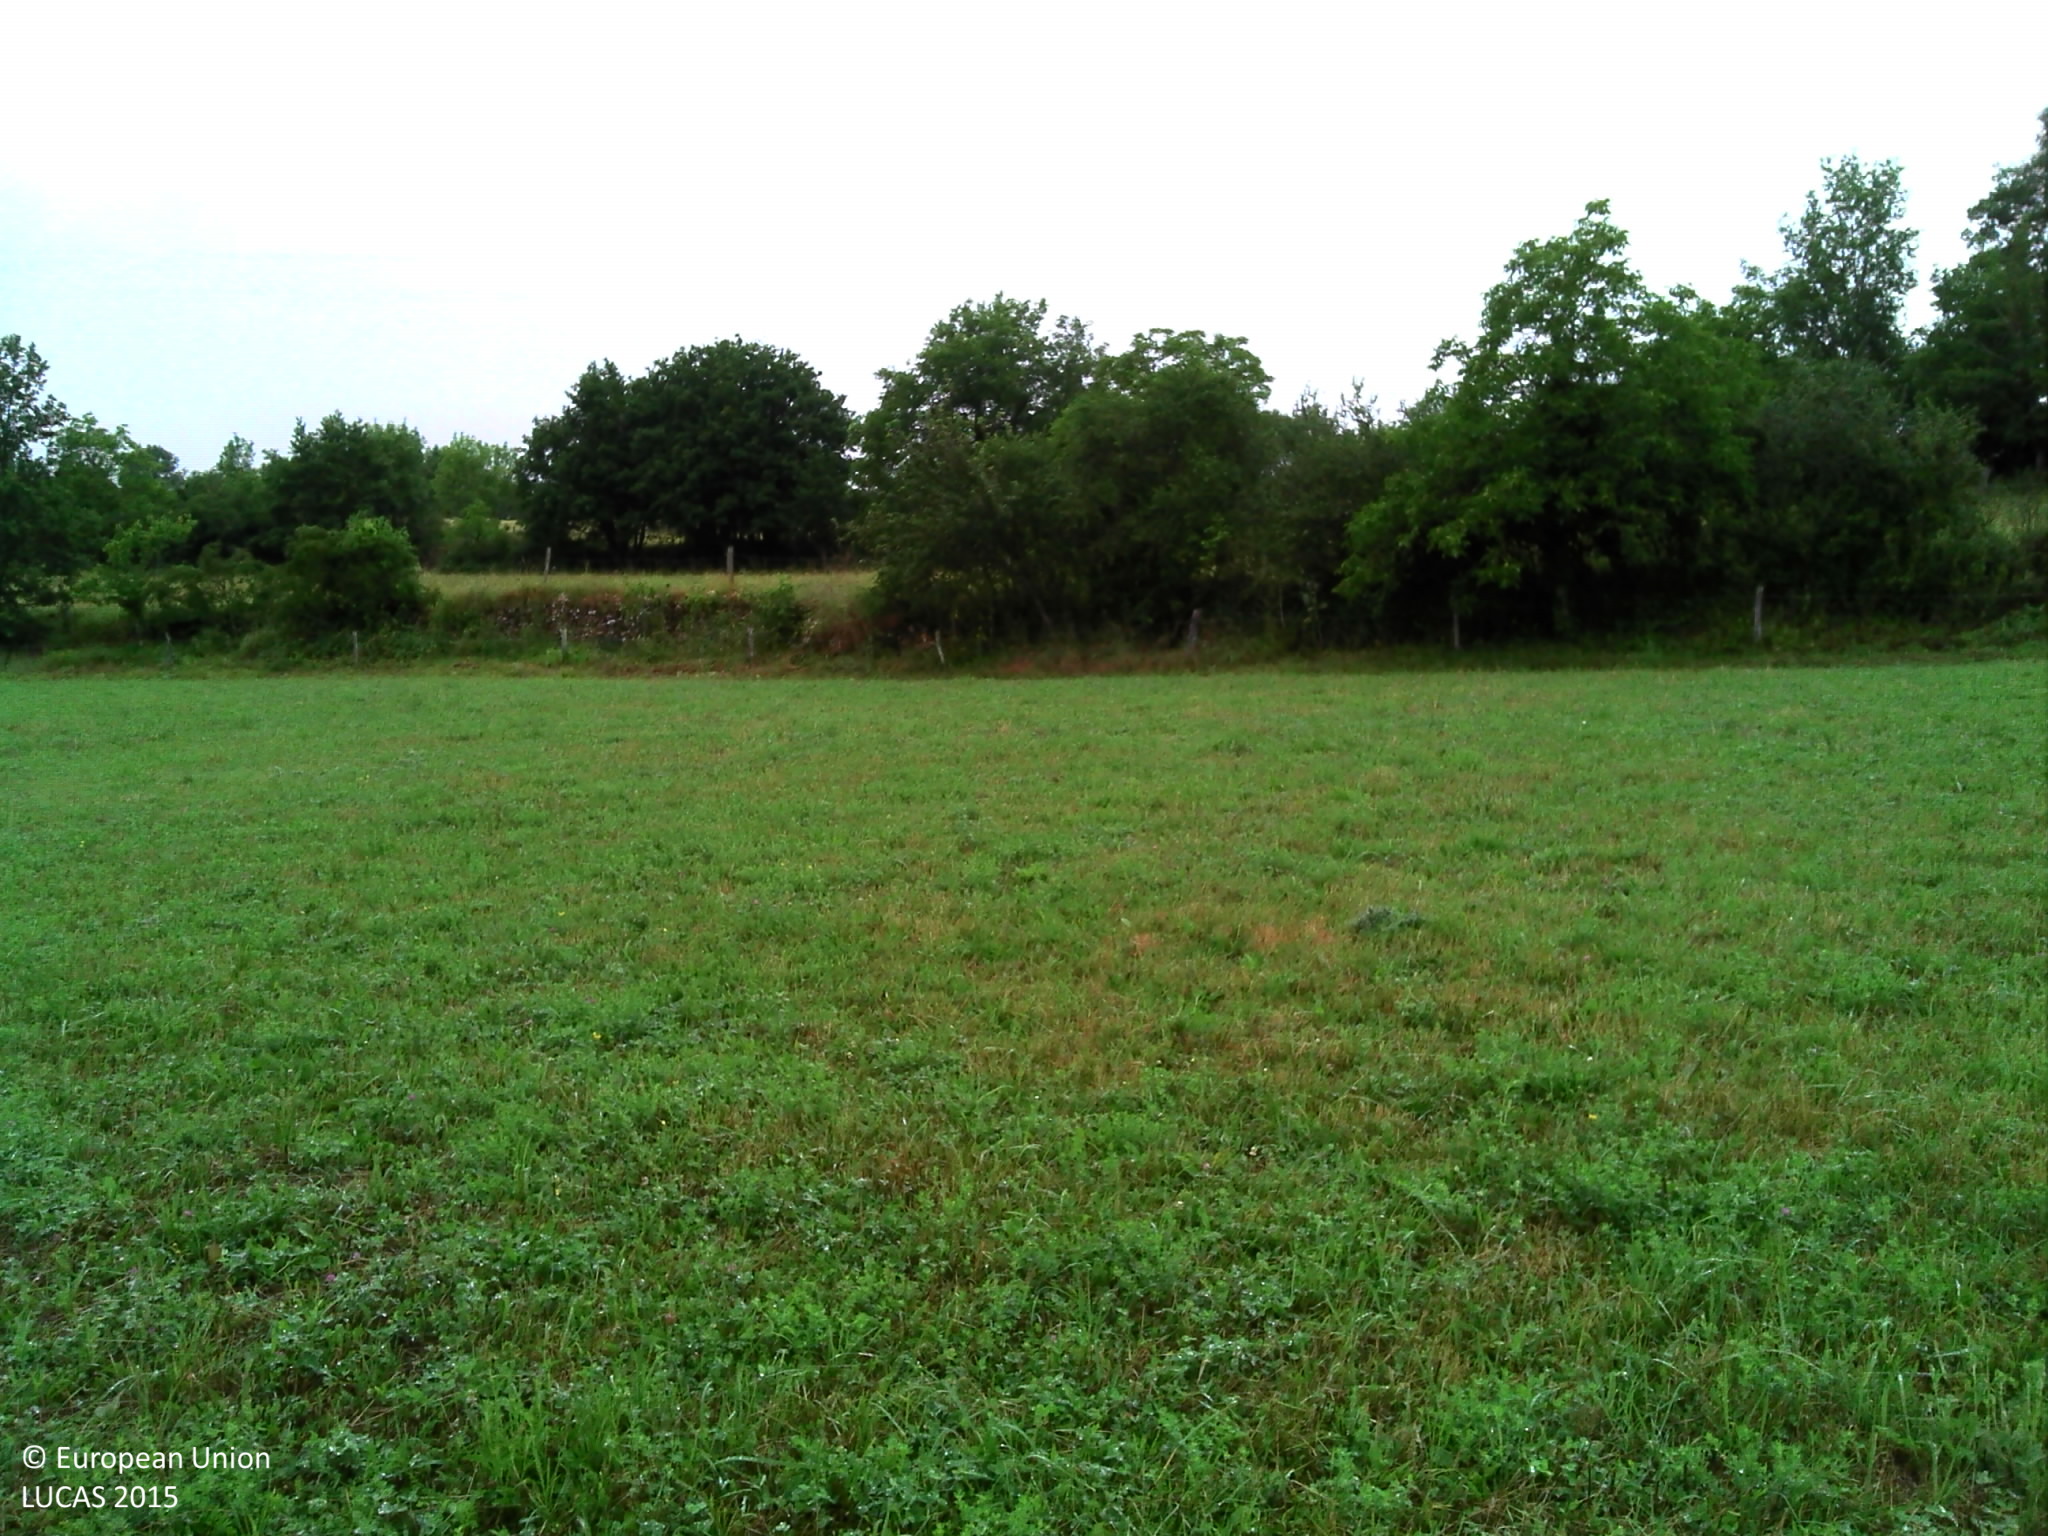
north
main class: Grassland
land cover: Grassland without tree/shrub cover
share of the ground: > 75 %
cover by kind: herbaceous plants 100 %
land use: Agriculture (excluding fallow land and kitchen gardens)
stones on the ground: 10 - 25 %
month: June
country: FR
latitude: 44.3700
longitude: 2.0326
